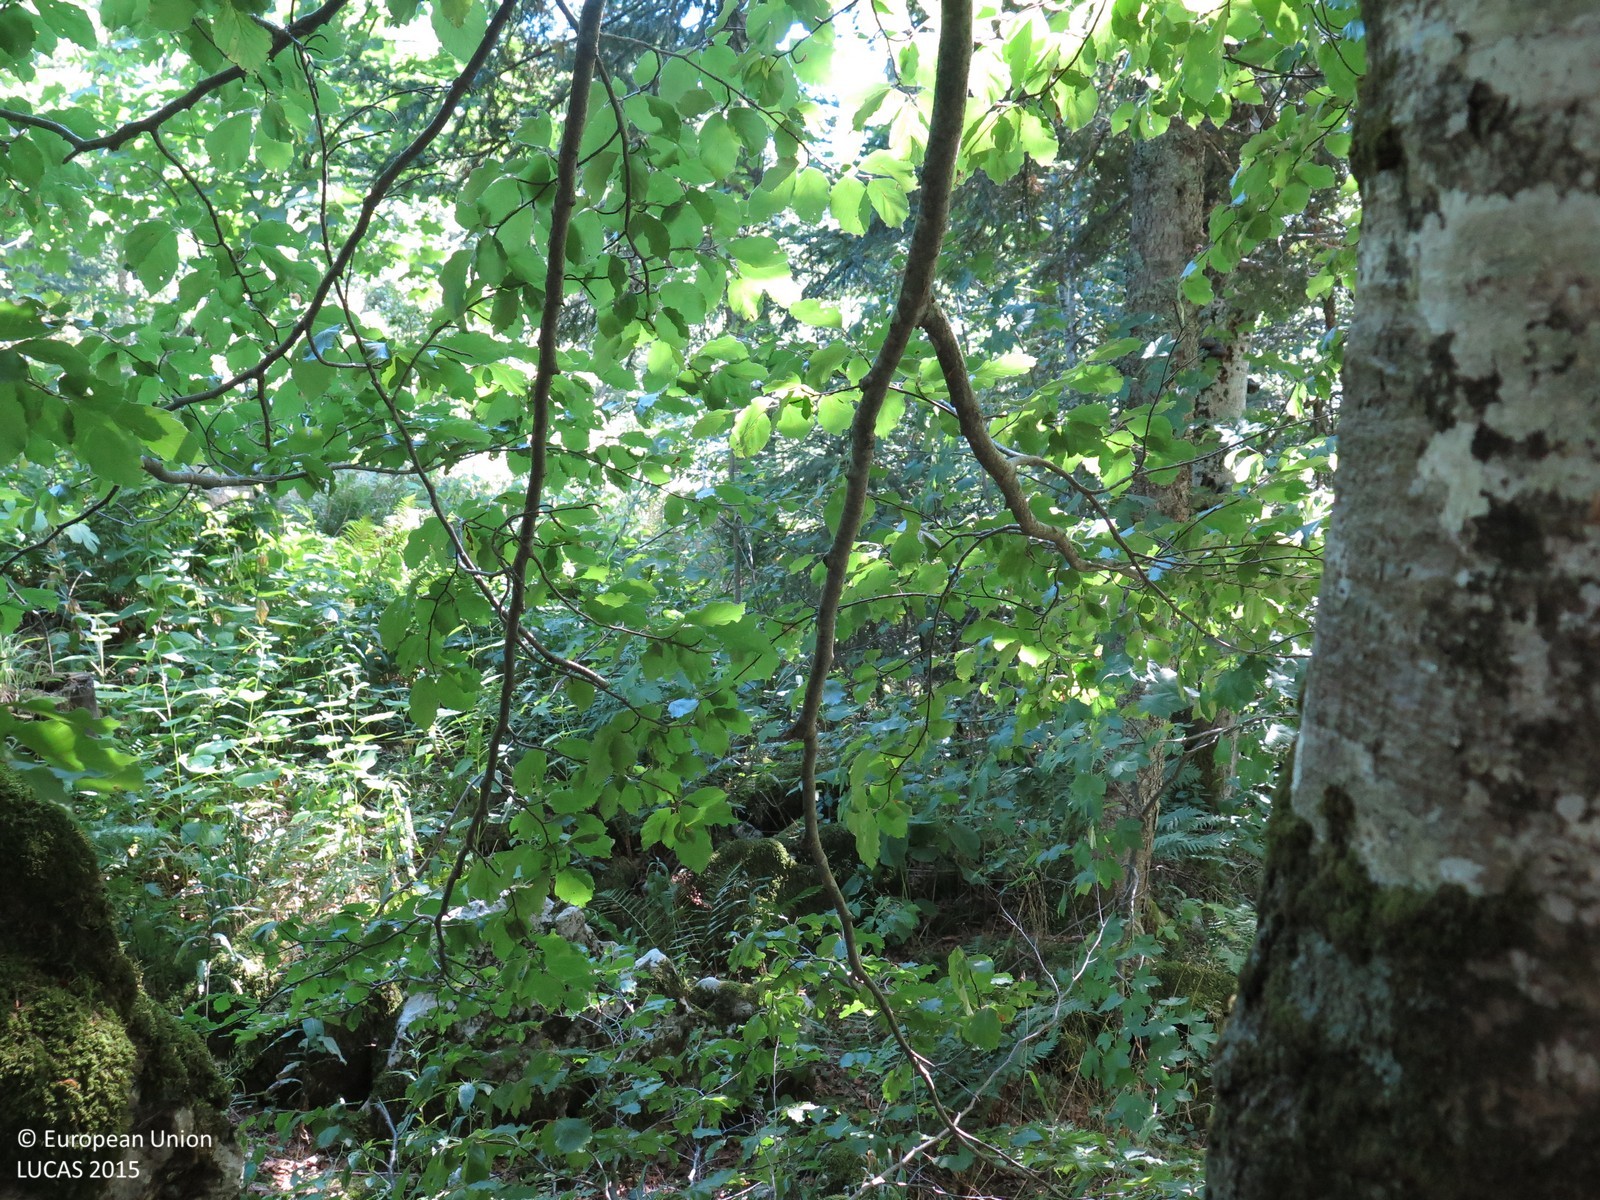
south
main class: Woodland
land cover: Other mixed woodland
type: mountainous beech forest
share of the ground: > 75 %
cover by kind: coniferous forest trees 75 %, broadleaved forest trees 25 %
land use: Forestry
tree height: > 5 m
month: August
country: HR
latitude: 45.2486
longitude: 14.8493
